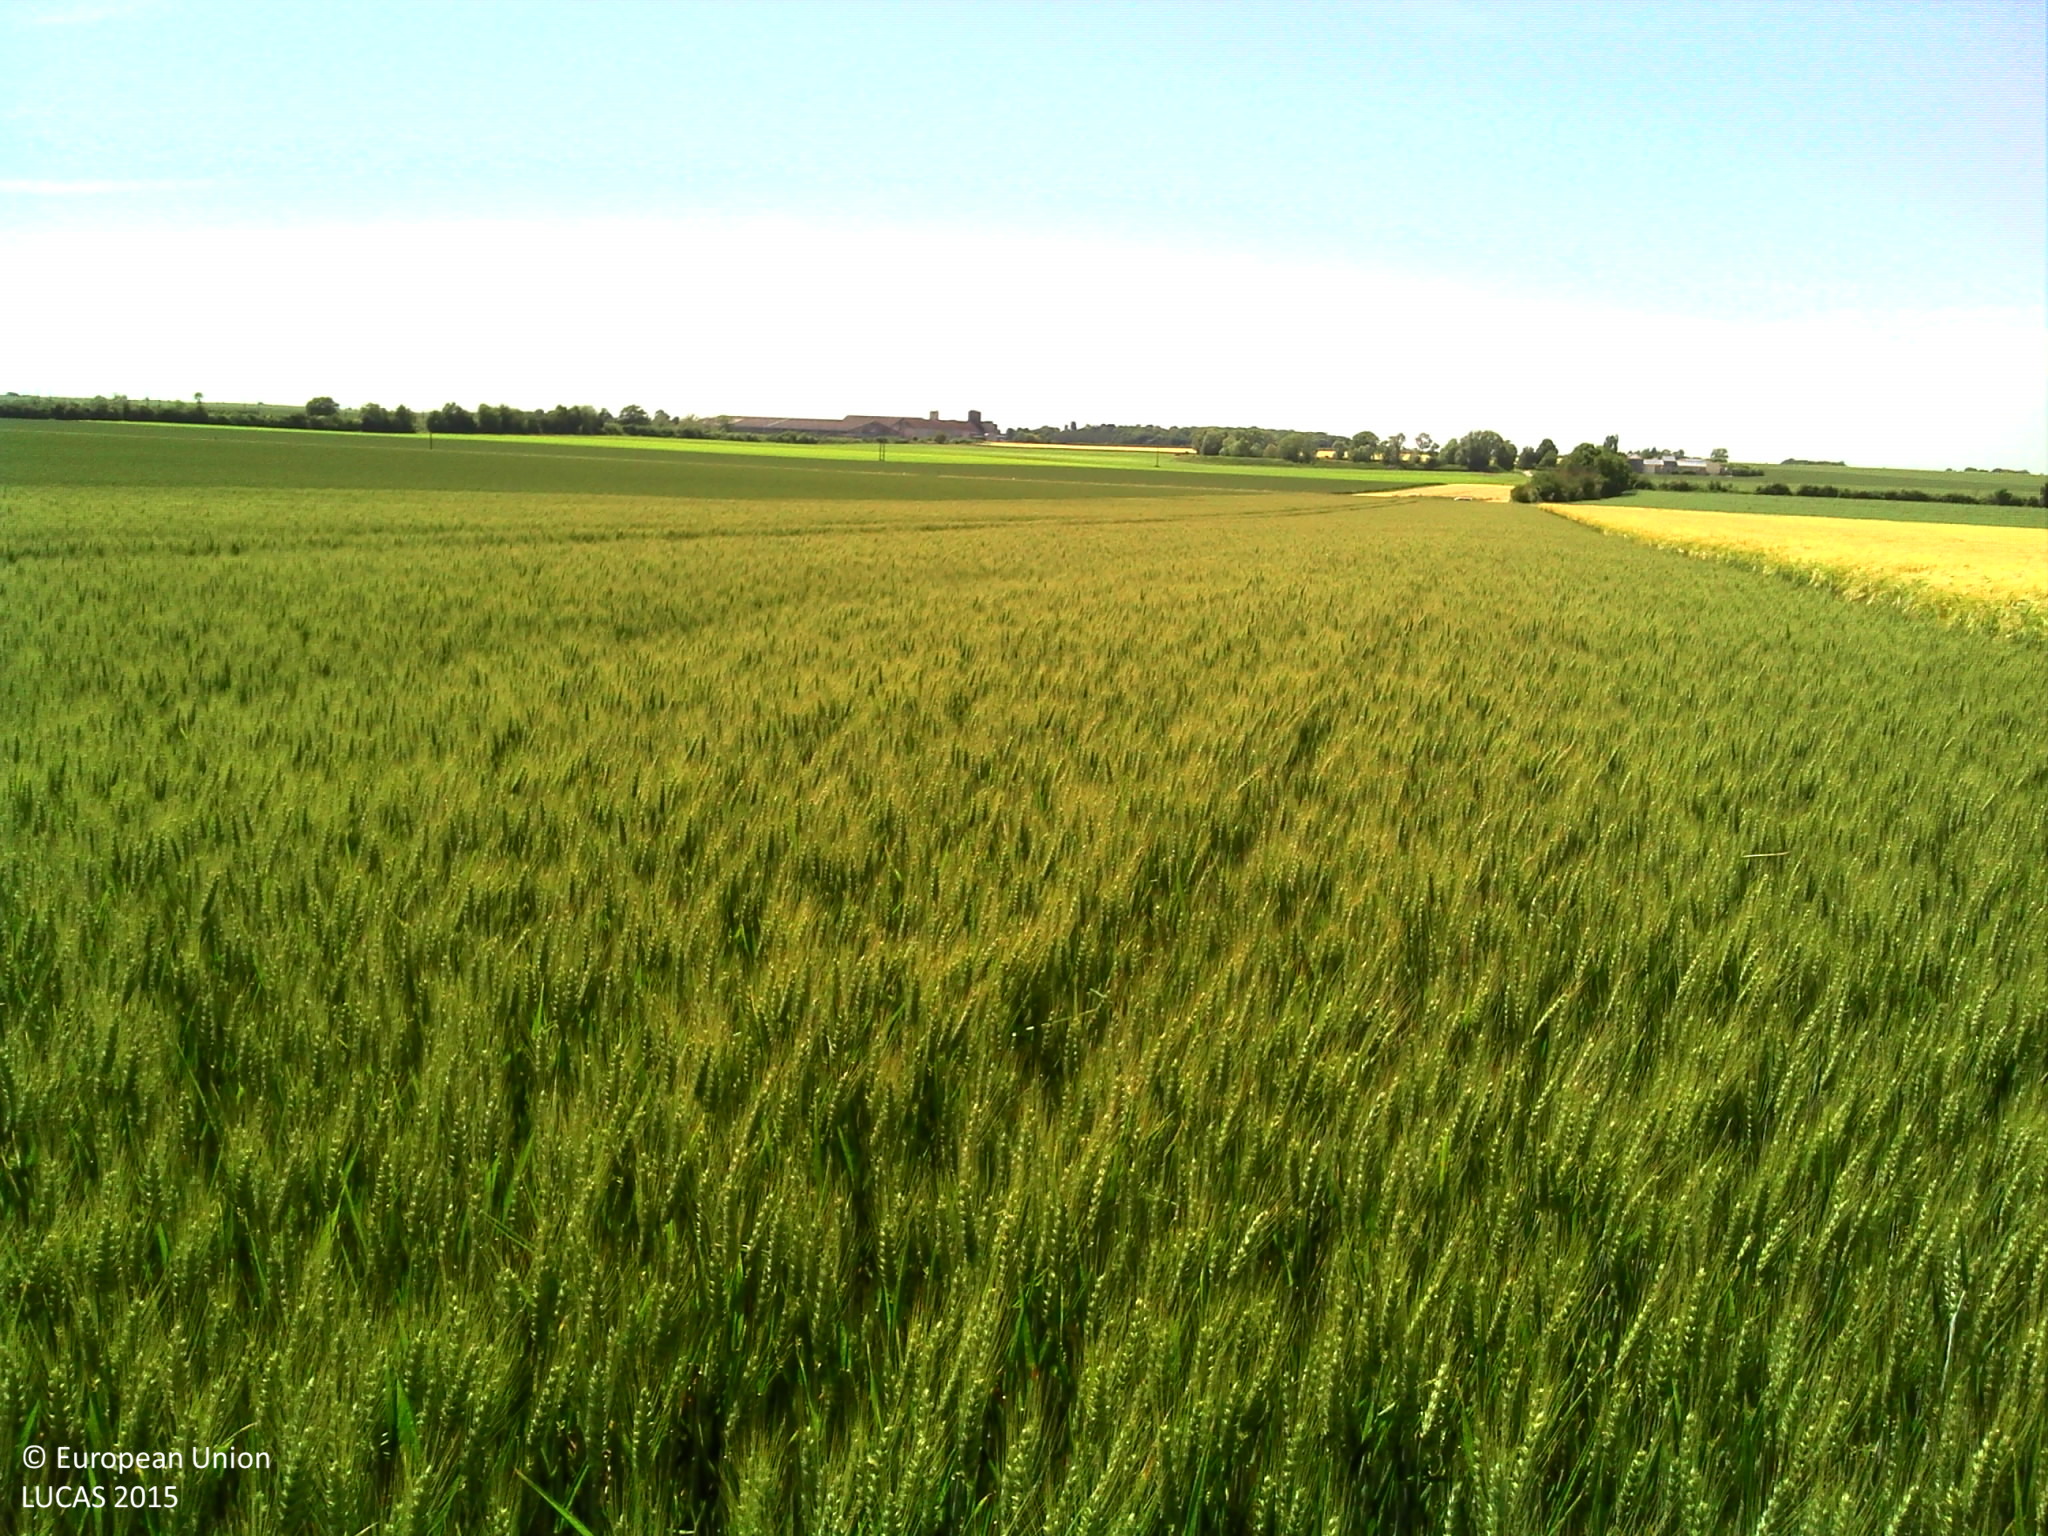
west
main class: Cropland
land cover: Common wheat
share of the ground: > 75 %
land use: Agriculture (excluding fallow land and kitchen gardens)
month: June
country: FR
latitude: 47.0249
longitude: 2.7184
